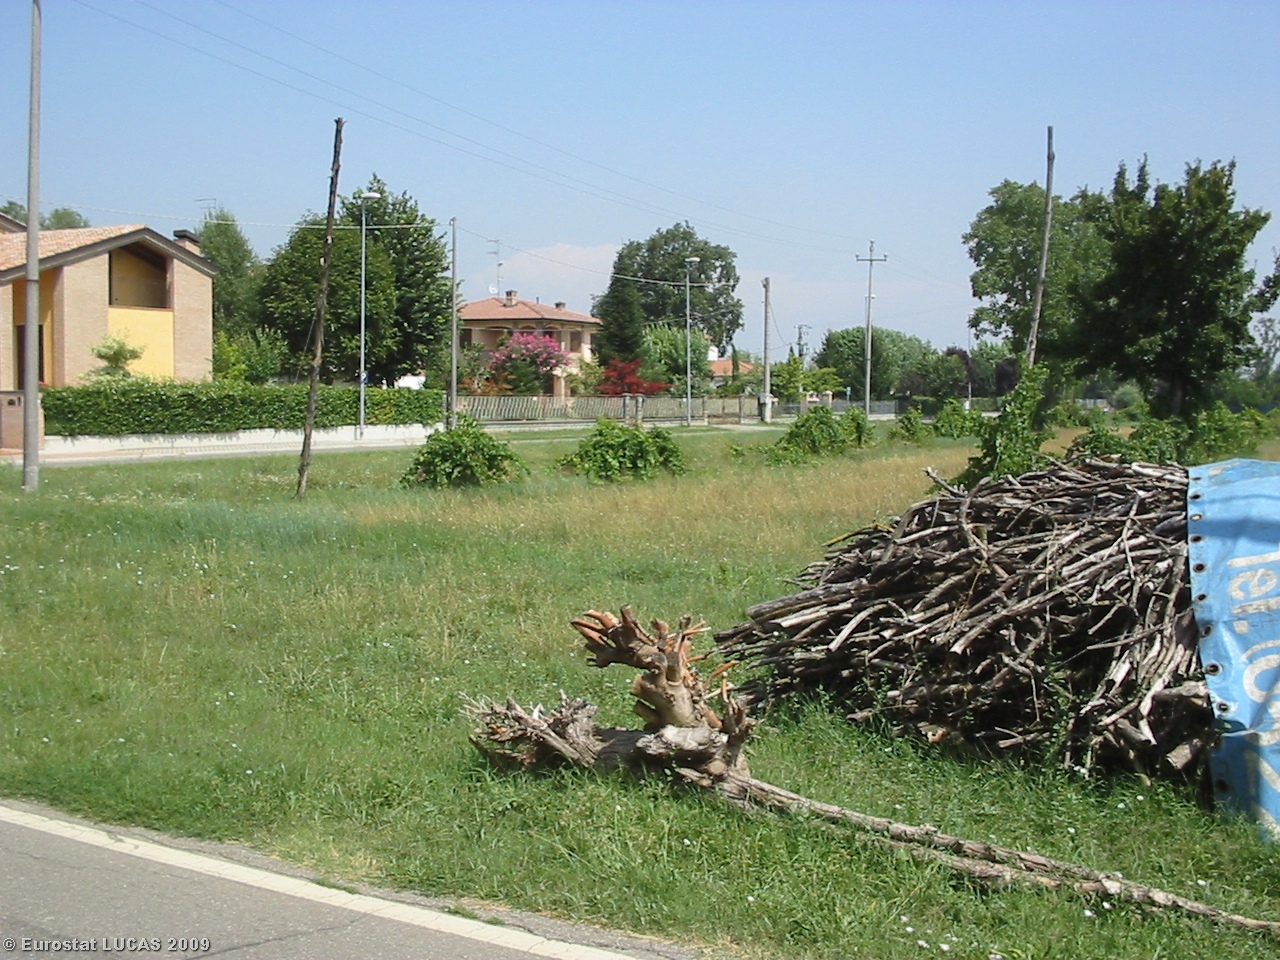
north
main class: Grassland
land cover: Grassland with sparse tree/shrub cover
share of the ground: > 75 %
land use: Residential
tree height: < 5 m
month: July
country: IT
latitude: 44.7464
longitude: 10.4411
